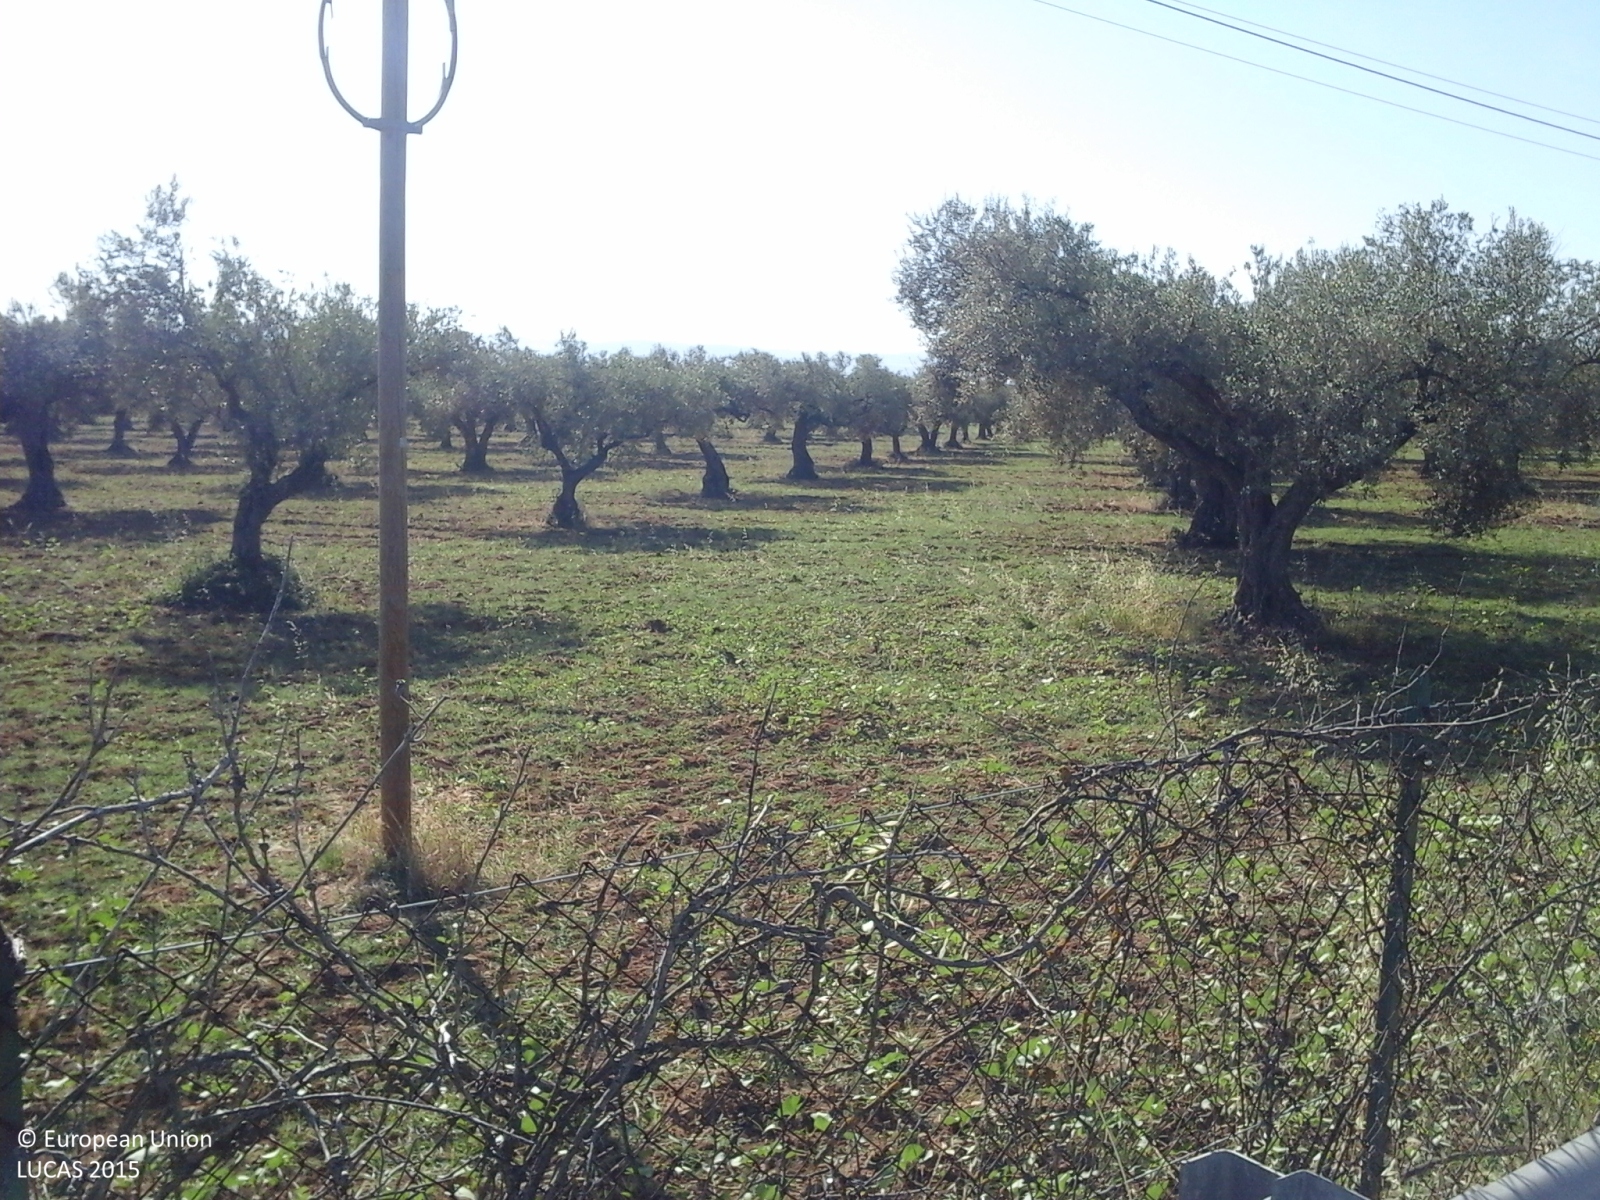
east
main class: Cropland
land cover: Olive groves
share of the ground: > 75 %
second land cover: Spontaneously vegetated surfaces
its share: > 75 %
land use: Agriculture (excluding fallow land and kitchen gardens)
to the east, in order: Olive groves; Spontaneously vegetated surfaces; Electric lines; Olive groves
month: May
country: IT
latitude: 37.0379
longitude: 14.5624
